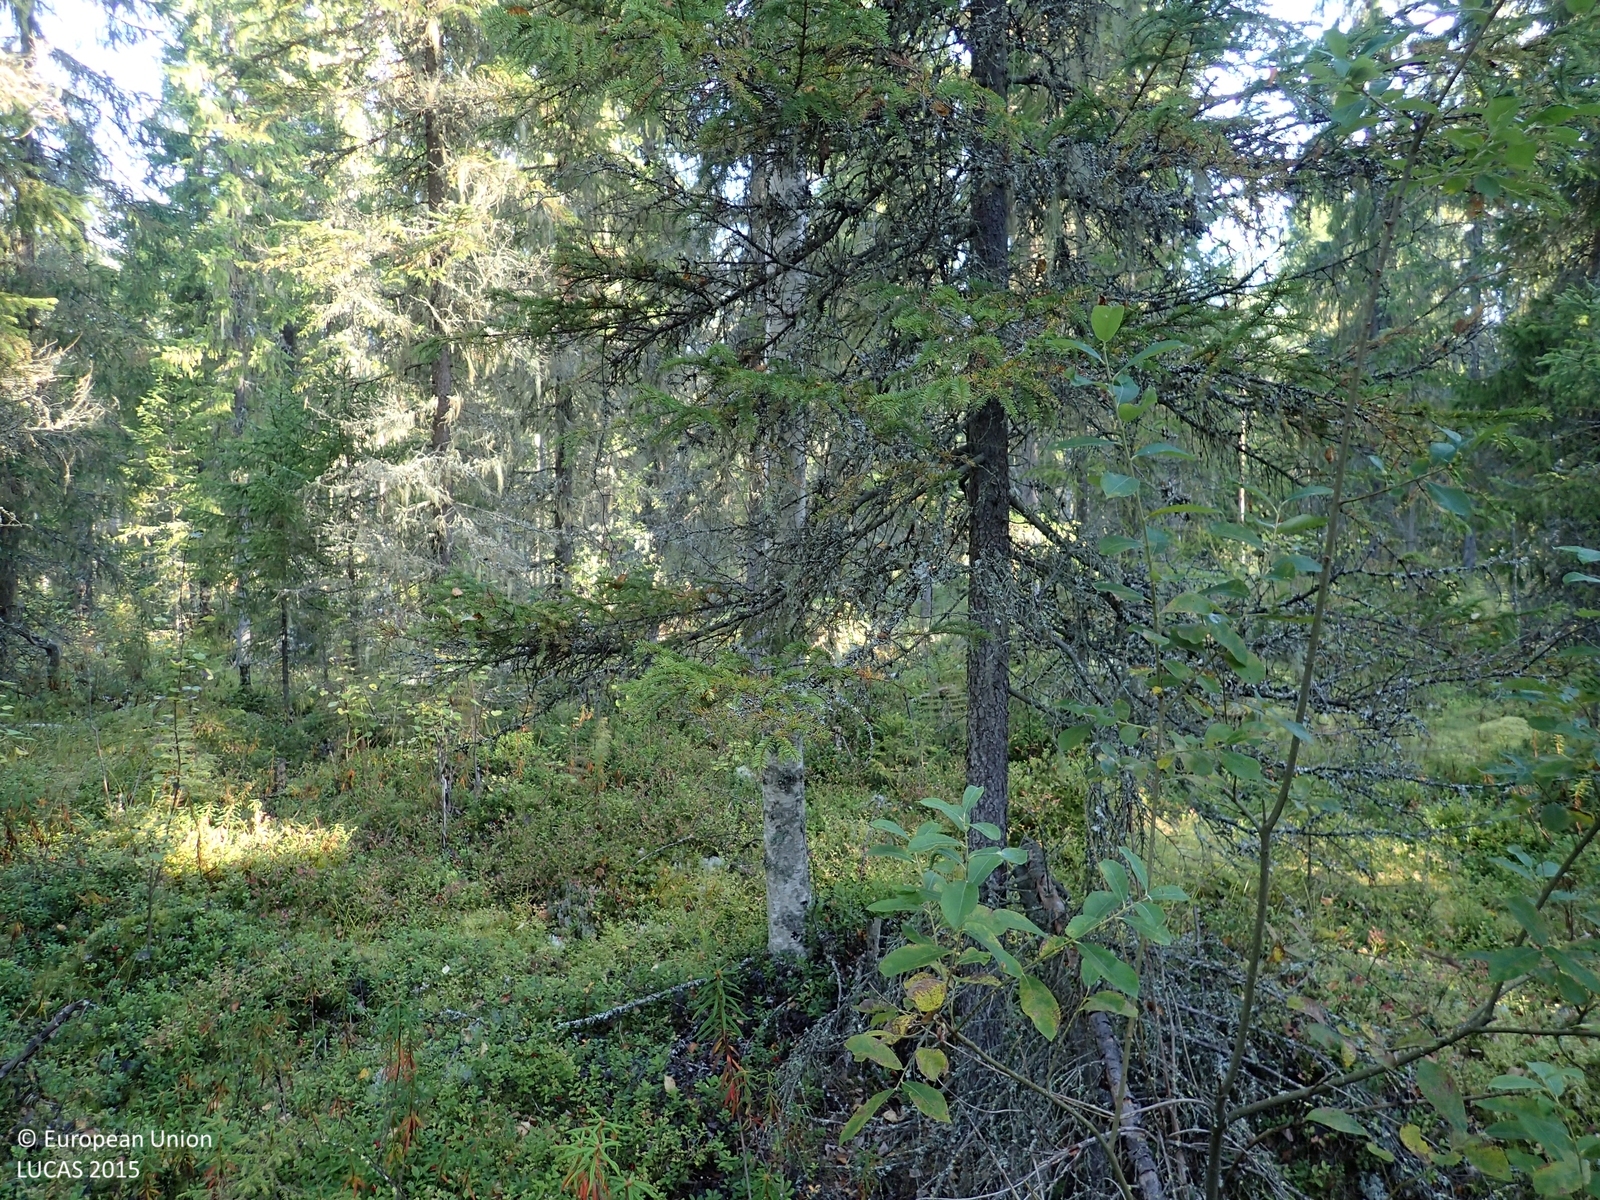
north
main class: Woodland
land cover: Spruce dominated coniferous woodland
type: boreal forest
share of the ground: > 75 %
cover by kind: coniferous forest trees 70 %, shrubs 15 %, broadleaved forest trees 5 %, herbaceous plants 5 %, lichens and mosses 5 %
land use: Forestry
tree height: > 5 m
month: September
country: FI
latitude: 63.0887
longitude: 25.3715
